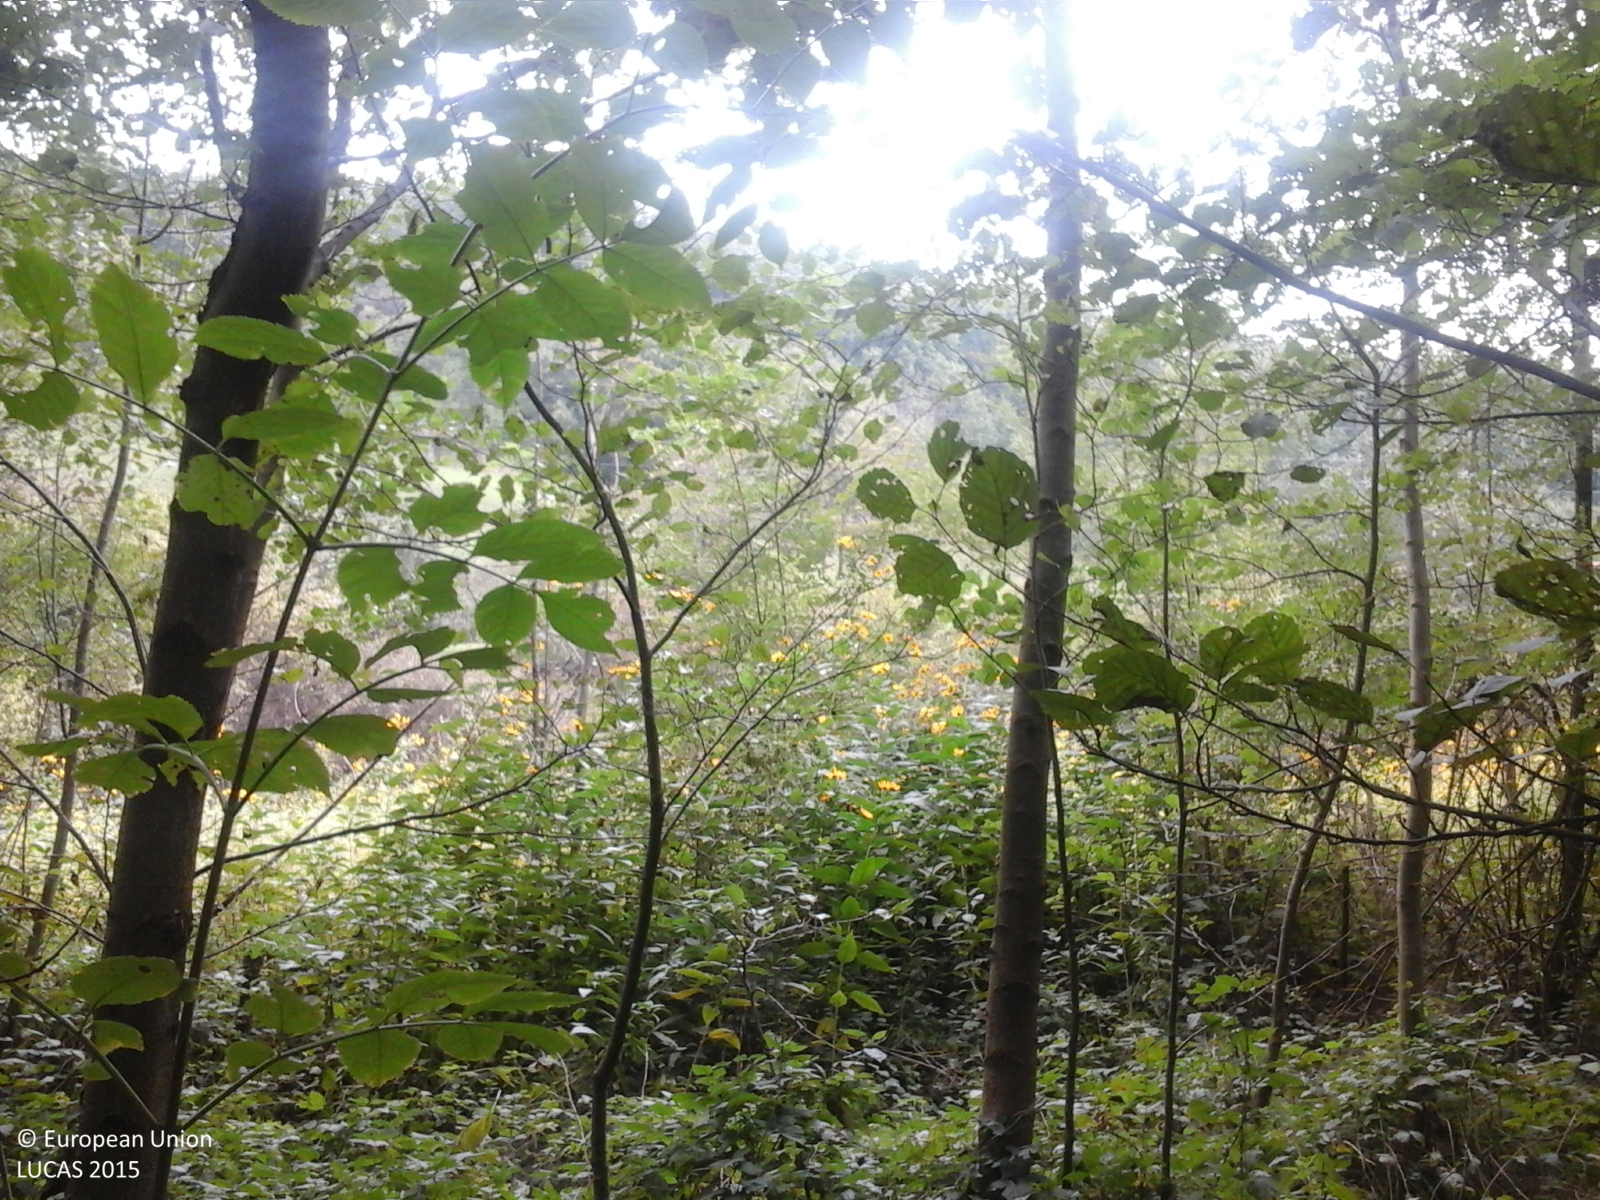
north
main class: Woodland
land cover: Broadleaved woodland
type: floodplain forest
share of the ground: > 75 %
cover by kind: broadleaved forest trees 80 %, herbaceous plants 15 %, shrubs 5 %
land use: Forestry
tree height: > 5 m
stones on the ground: < 10 %
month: October
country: RO
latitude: 46.0910
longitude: 23.3716
